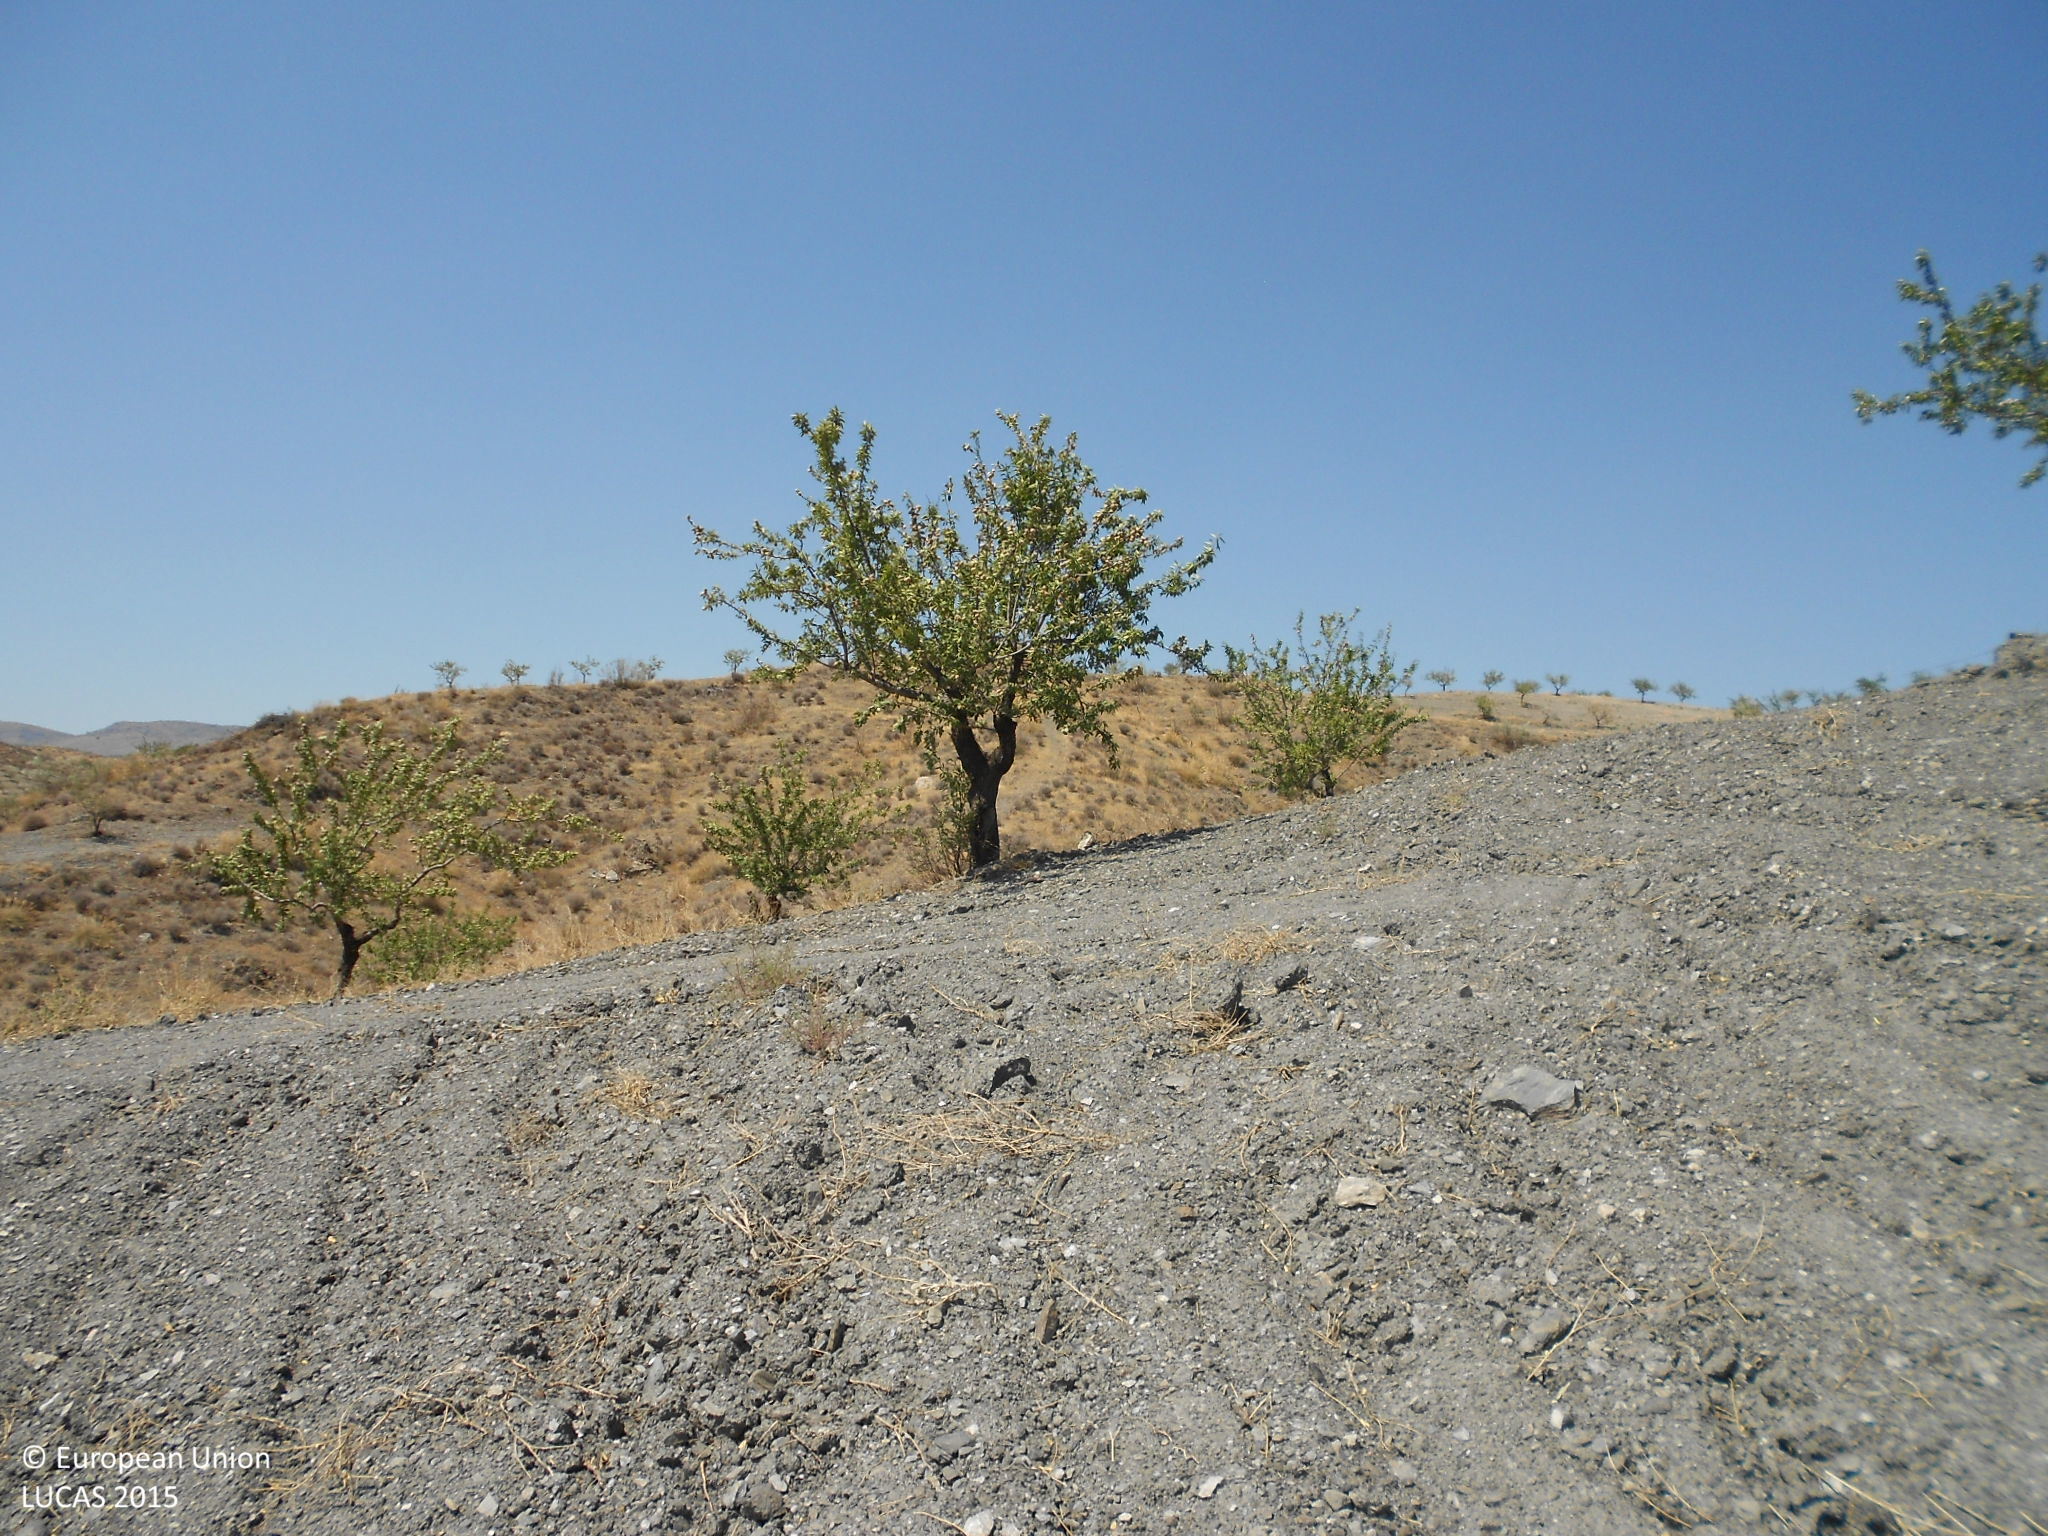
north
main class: Cropland
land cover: Nuts trees
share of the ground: 10 - 25 %
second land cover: Other bare soil
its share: > 75 %
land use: Agriculture (excluding fallow land and kitchen gardens)
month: July
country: ES
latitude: 37.4474
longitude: -2.2471
